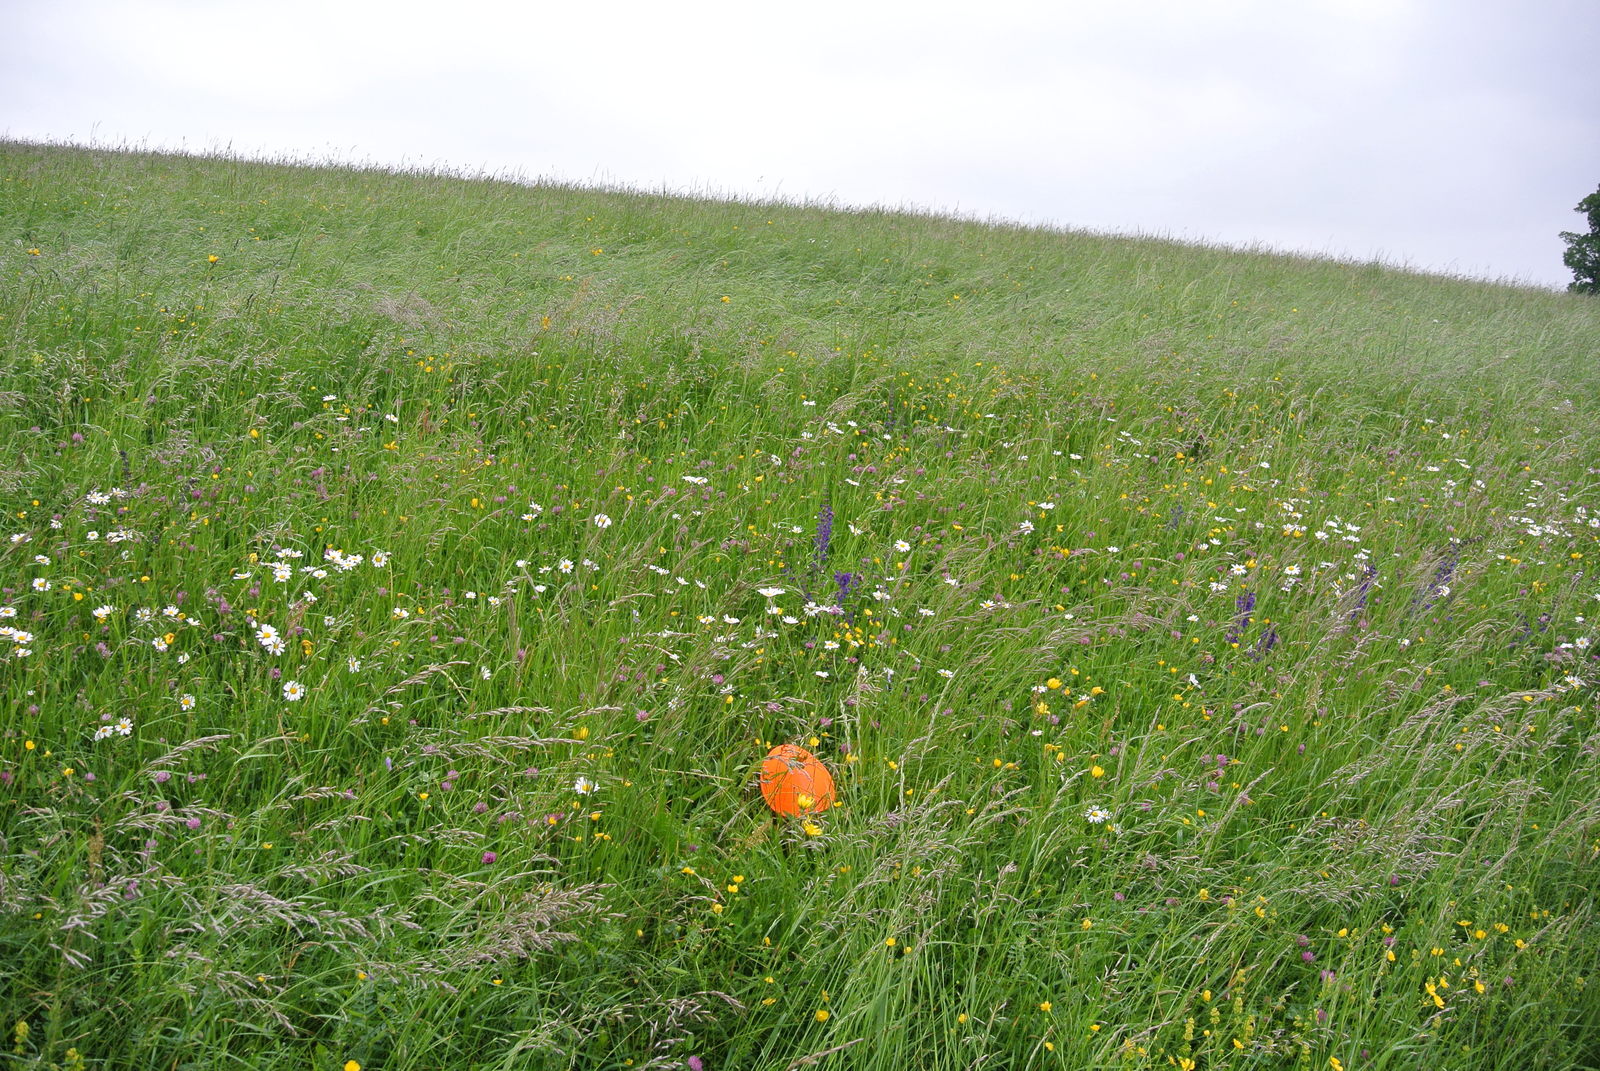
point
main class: Grassland
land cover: Grassland without tree/shrub cover
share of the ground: > 75 %
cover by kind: herbaceous plants 100 %
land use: Agriculture (excluding fallow land and kitchen gardens)
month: May
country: AT
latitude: 48.1074
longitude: 15.7914
